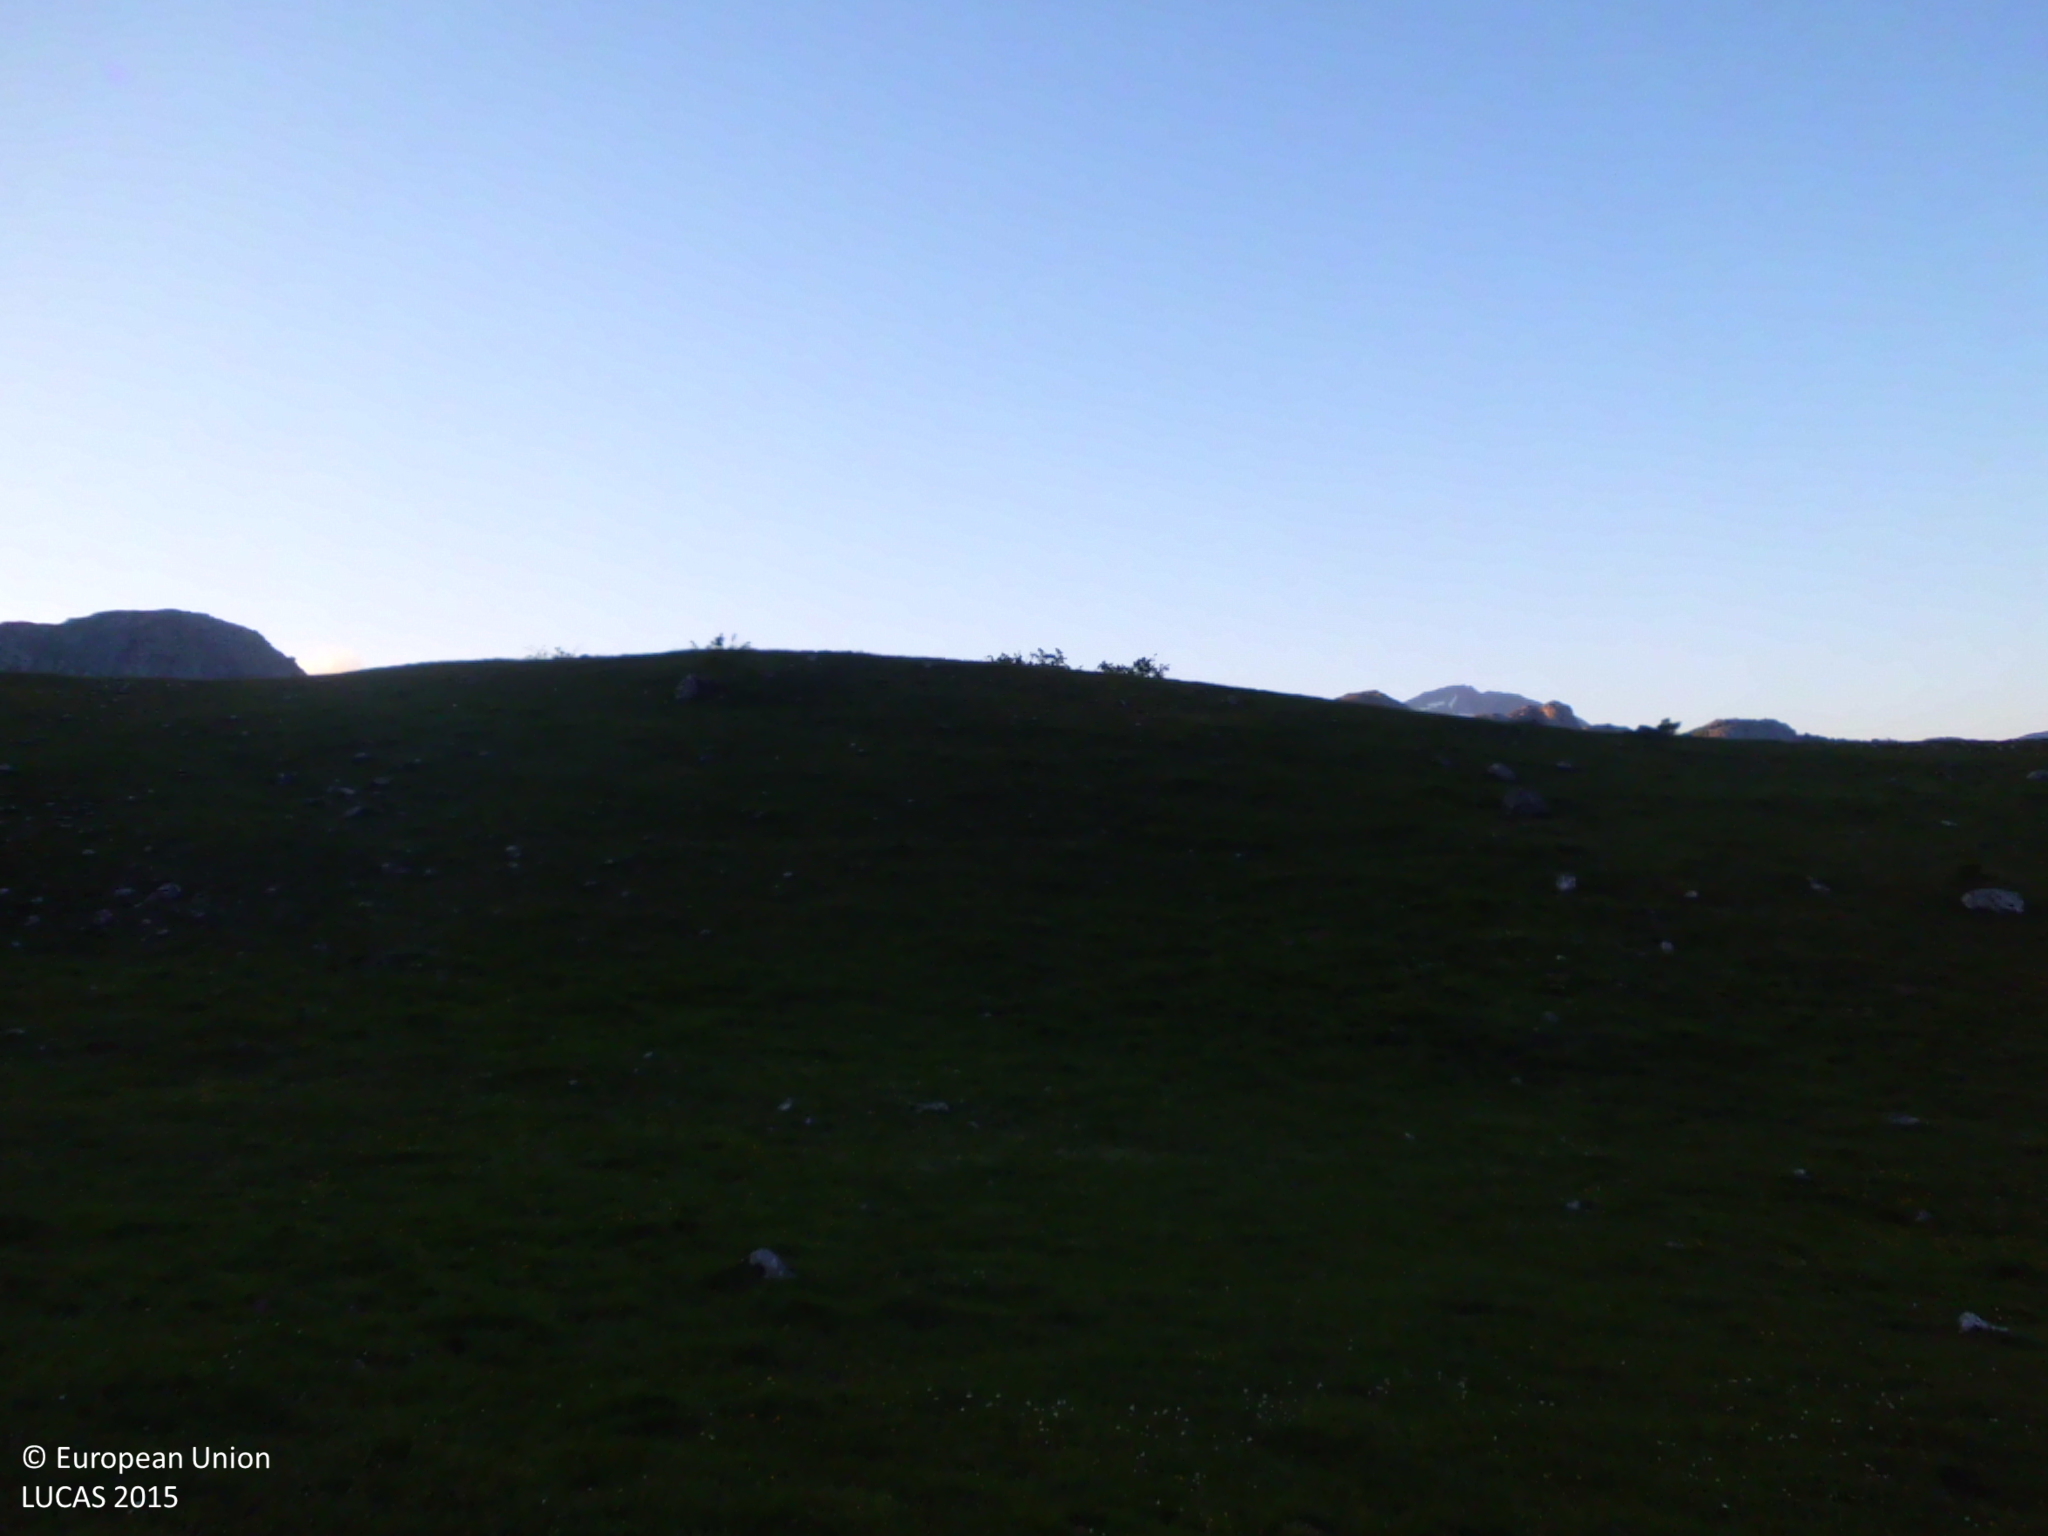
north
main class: Grassland
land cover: Grassland without tree/shrub cover
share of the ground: > 75 %
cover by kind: herbaceous plants 100 %
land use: Agriculture (excluding fallow land and kitchen gardens)
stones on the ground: < 10 %
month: May
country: ES
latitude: 43.0426
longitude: -5.1807
